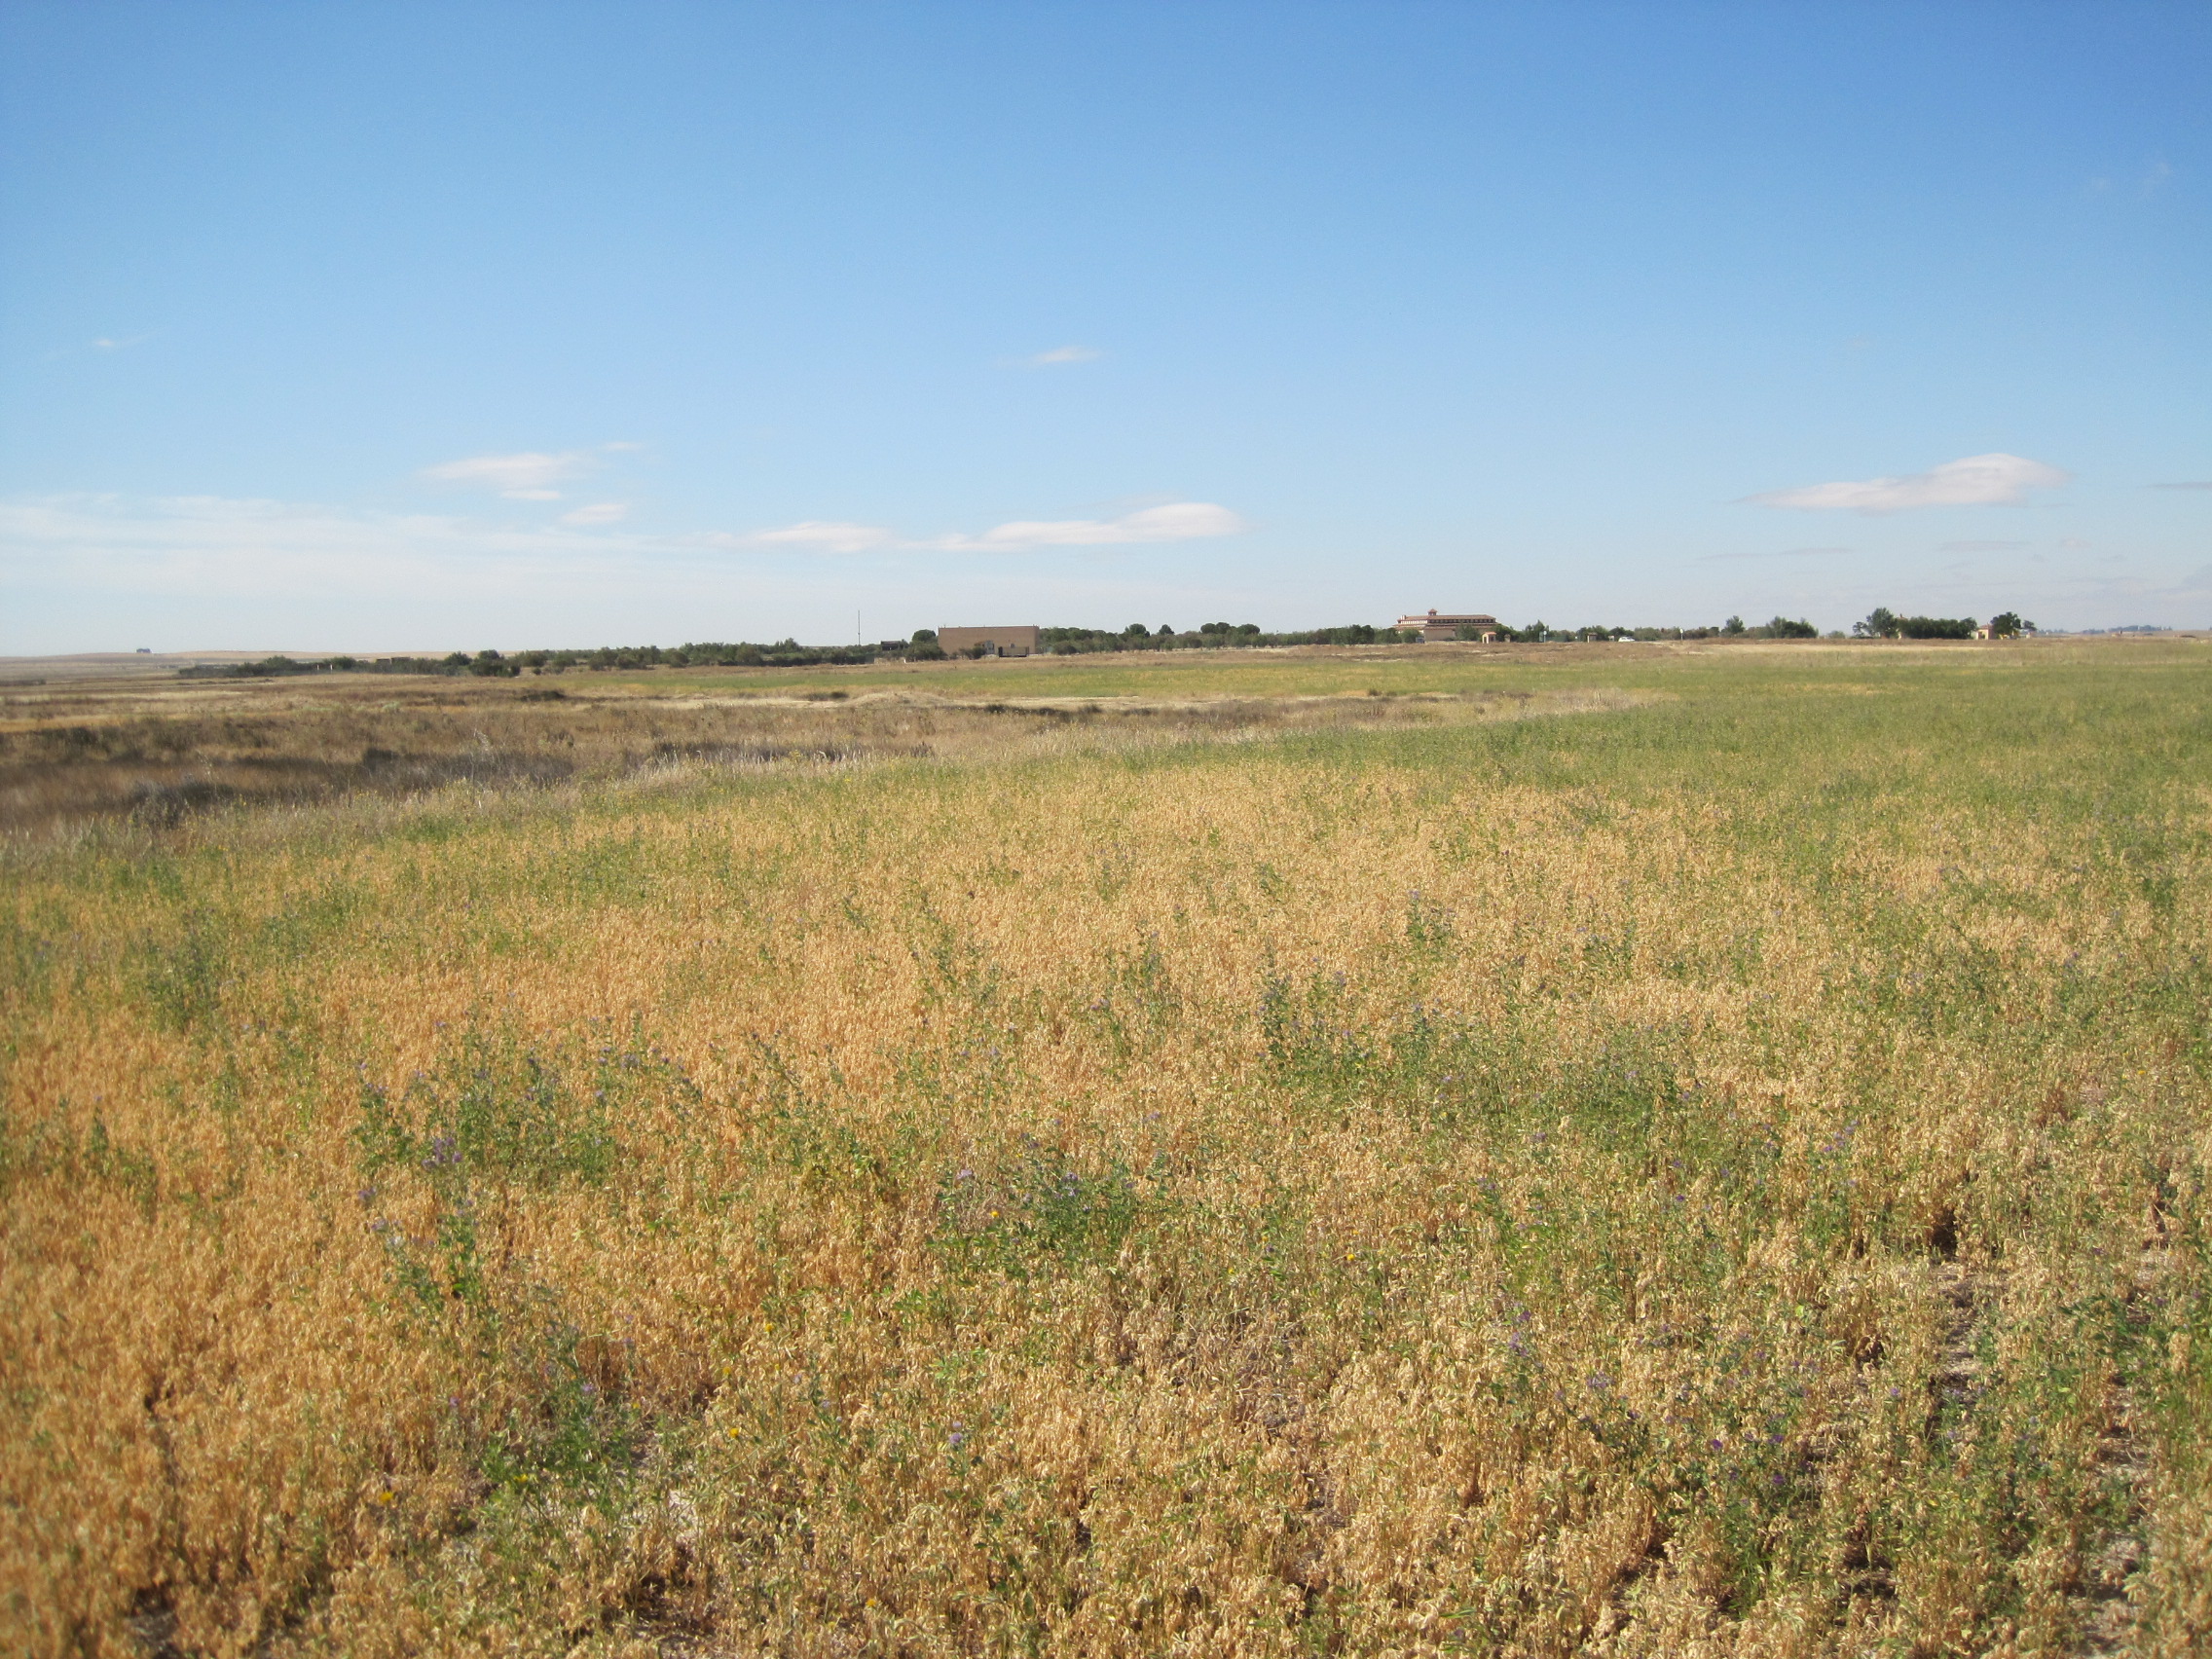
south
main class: Cropland
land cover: Lucerne
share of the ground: > 75 %
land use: Agriculture (excluding fallow land and kitchen gardens)
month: July
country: ES
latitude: 41.8602
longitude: -5.5920
